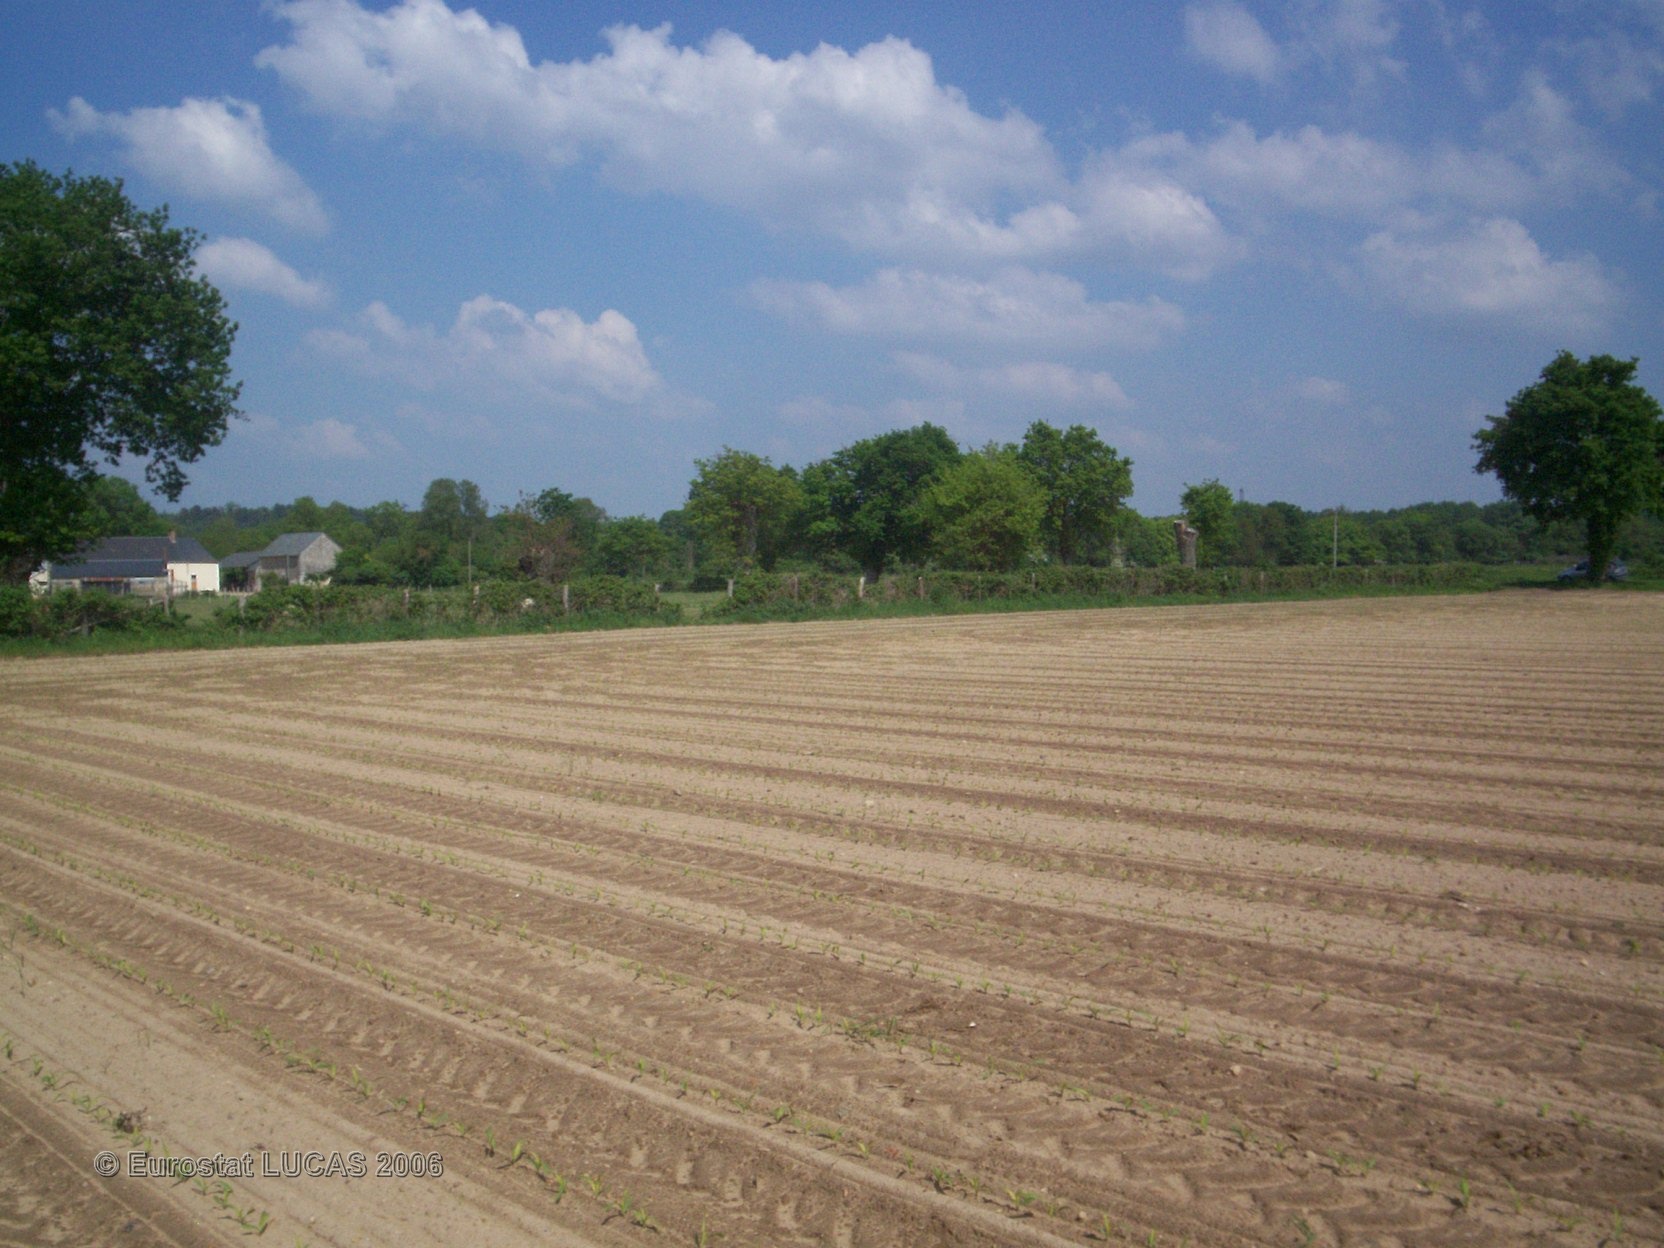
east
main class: Cropland
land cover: Maize
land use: Agriculture (excluding fallow land and kitchen gardens)
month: May
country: FR
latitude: 47.6402
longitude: 0.1920
